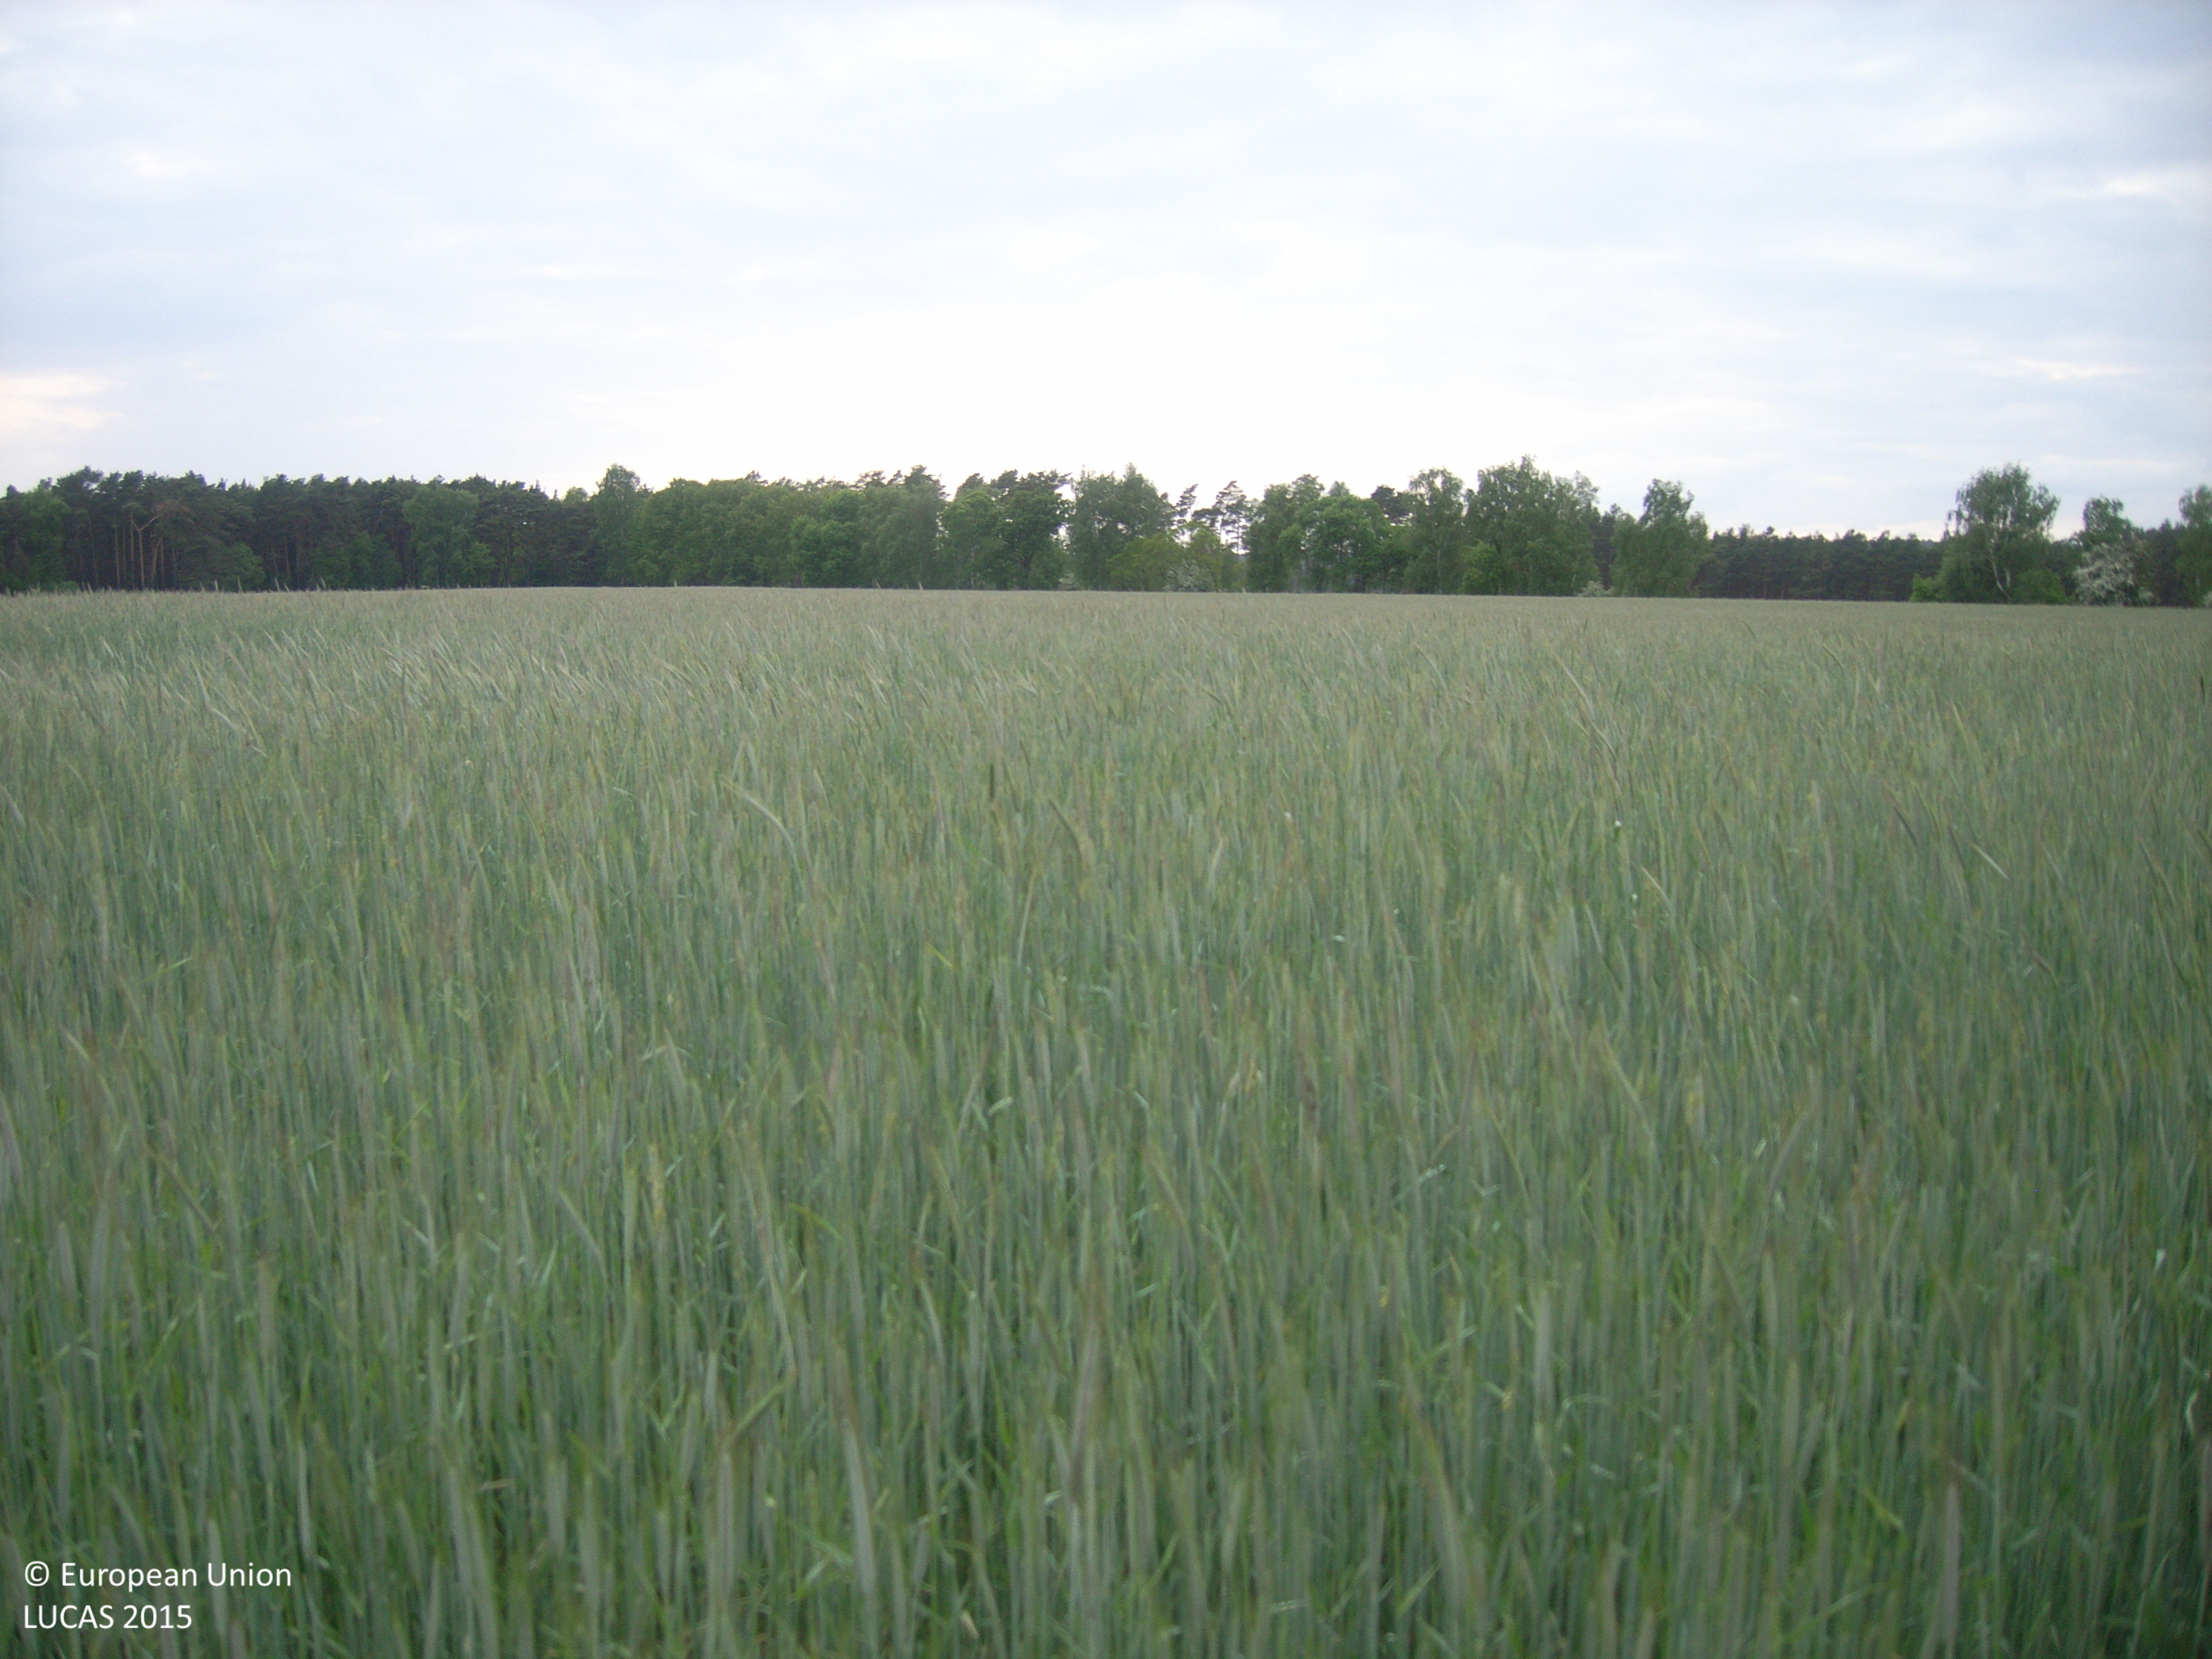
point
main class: Cropland
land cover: Rye
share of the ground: > 75 %
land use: Agriculture (excluding fallow land and kitchen gardens)
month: May
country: DE
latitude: 52.2057
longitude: 14.4061
